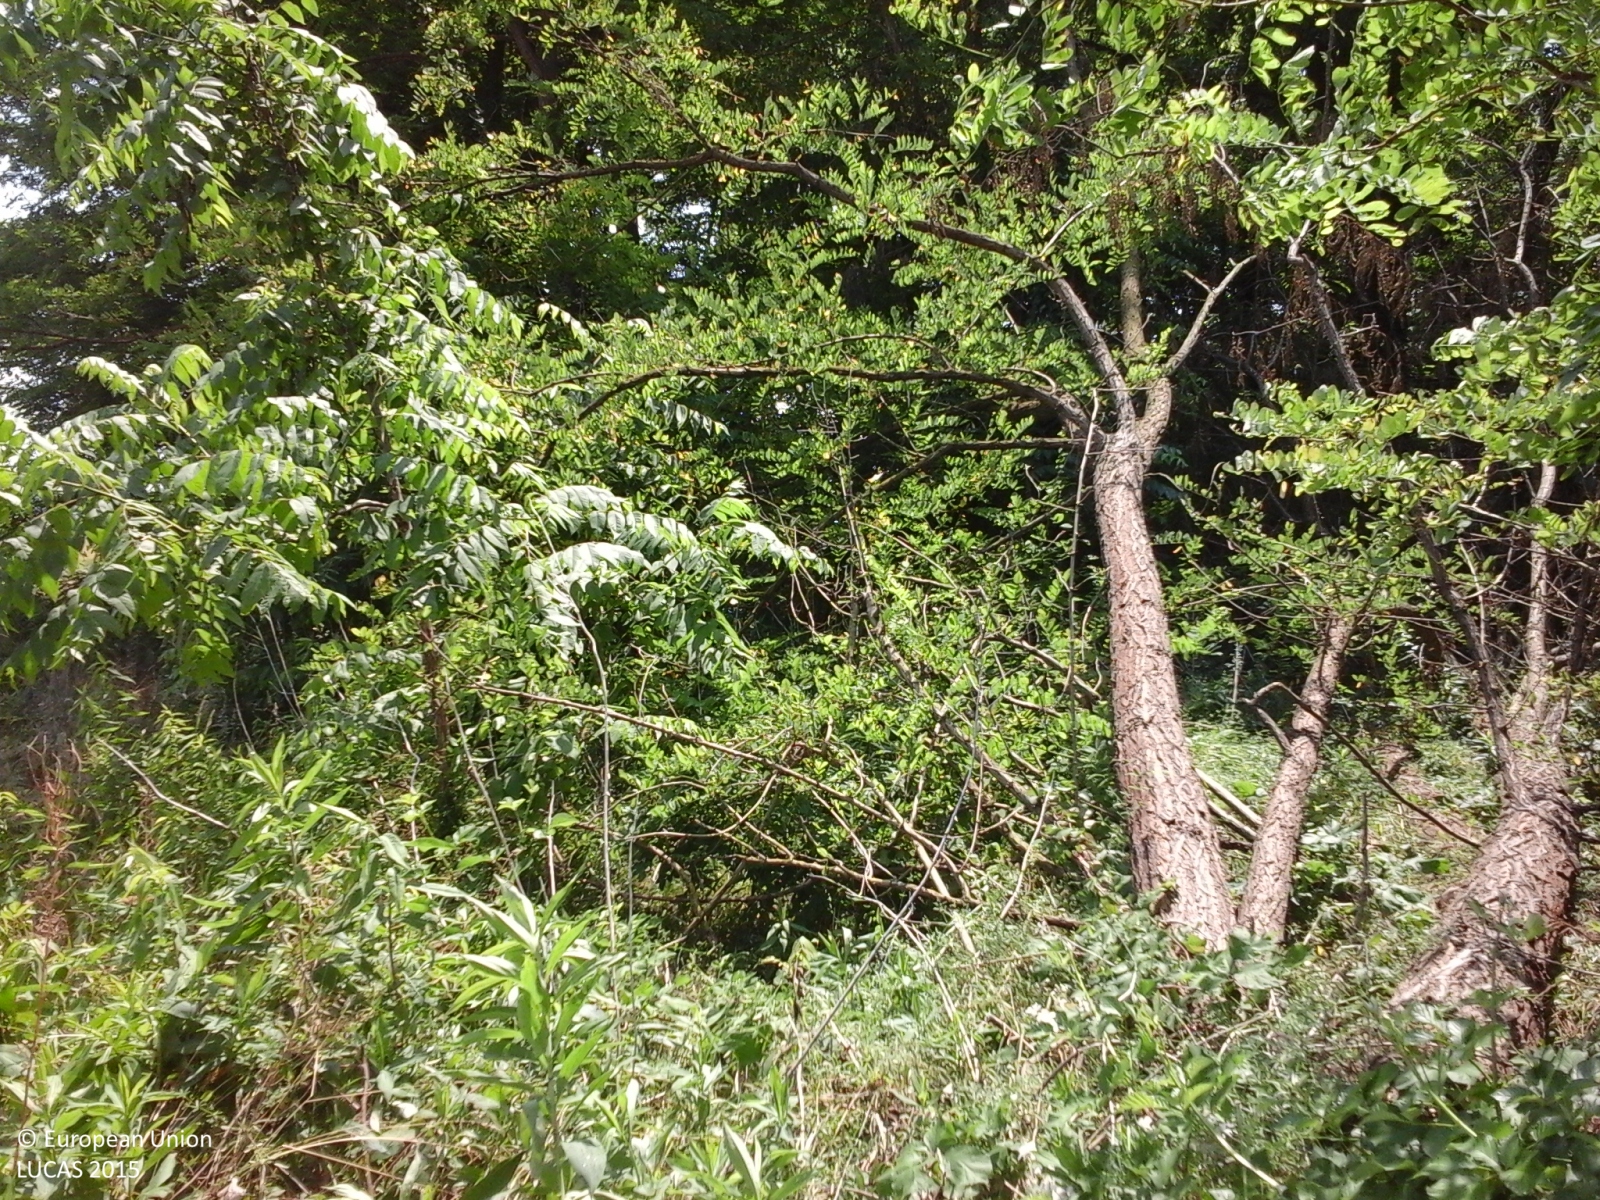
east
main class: Woodland
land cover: Broadleaved woodland
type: thermophilous deciduous forest
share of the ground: > 75 %
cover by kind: broadleaved forest trees 100 %
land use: Semi-natural and natural areas not in use
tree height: > 5 m
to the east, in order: Broadleaved woodland; Spontaneously vegetated surfaces; Barley; Grassland without tree/shrub cover; Common wheat; Shrubland without tree cover; Temporary grasslands
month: June
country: IT
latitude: 44.9217
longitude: 7.7618
